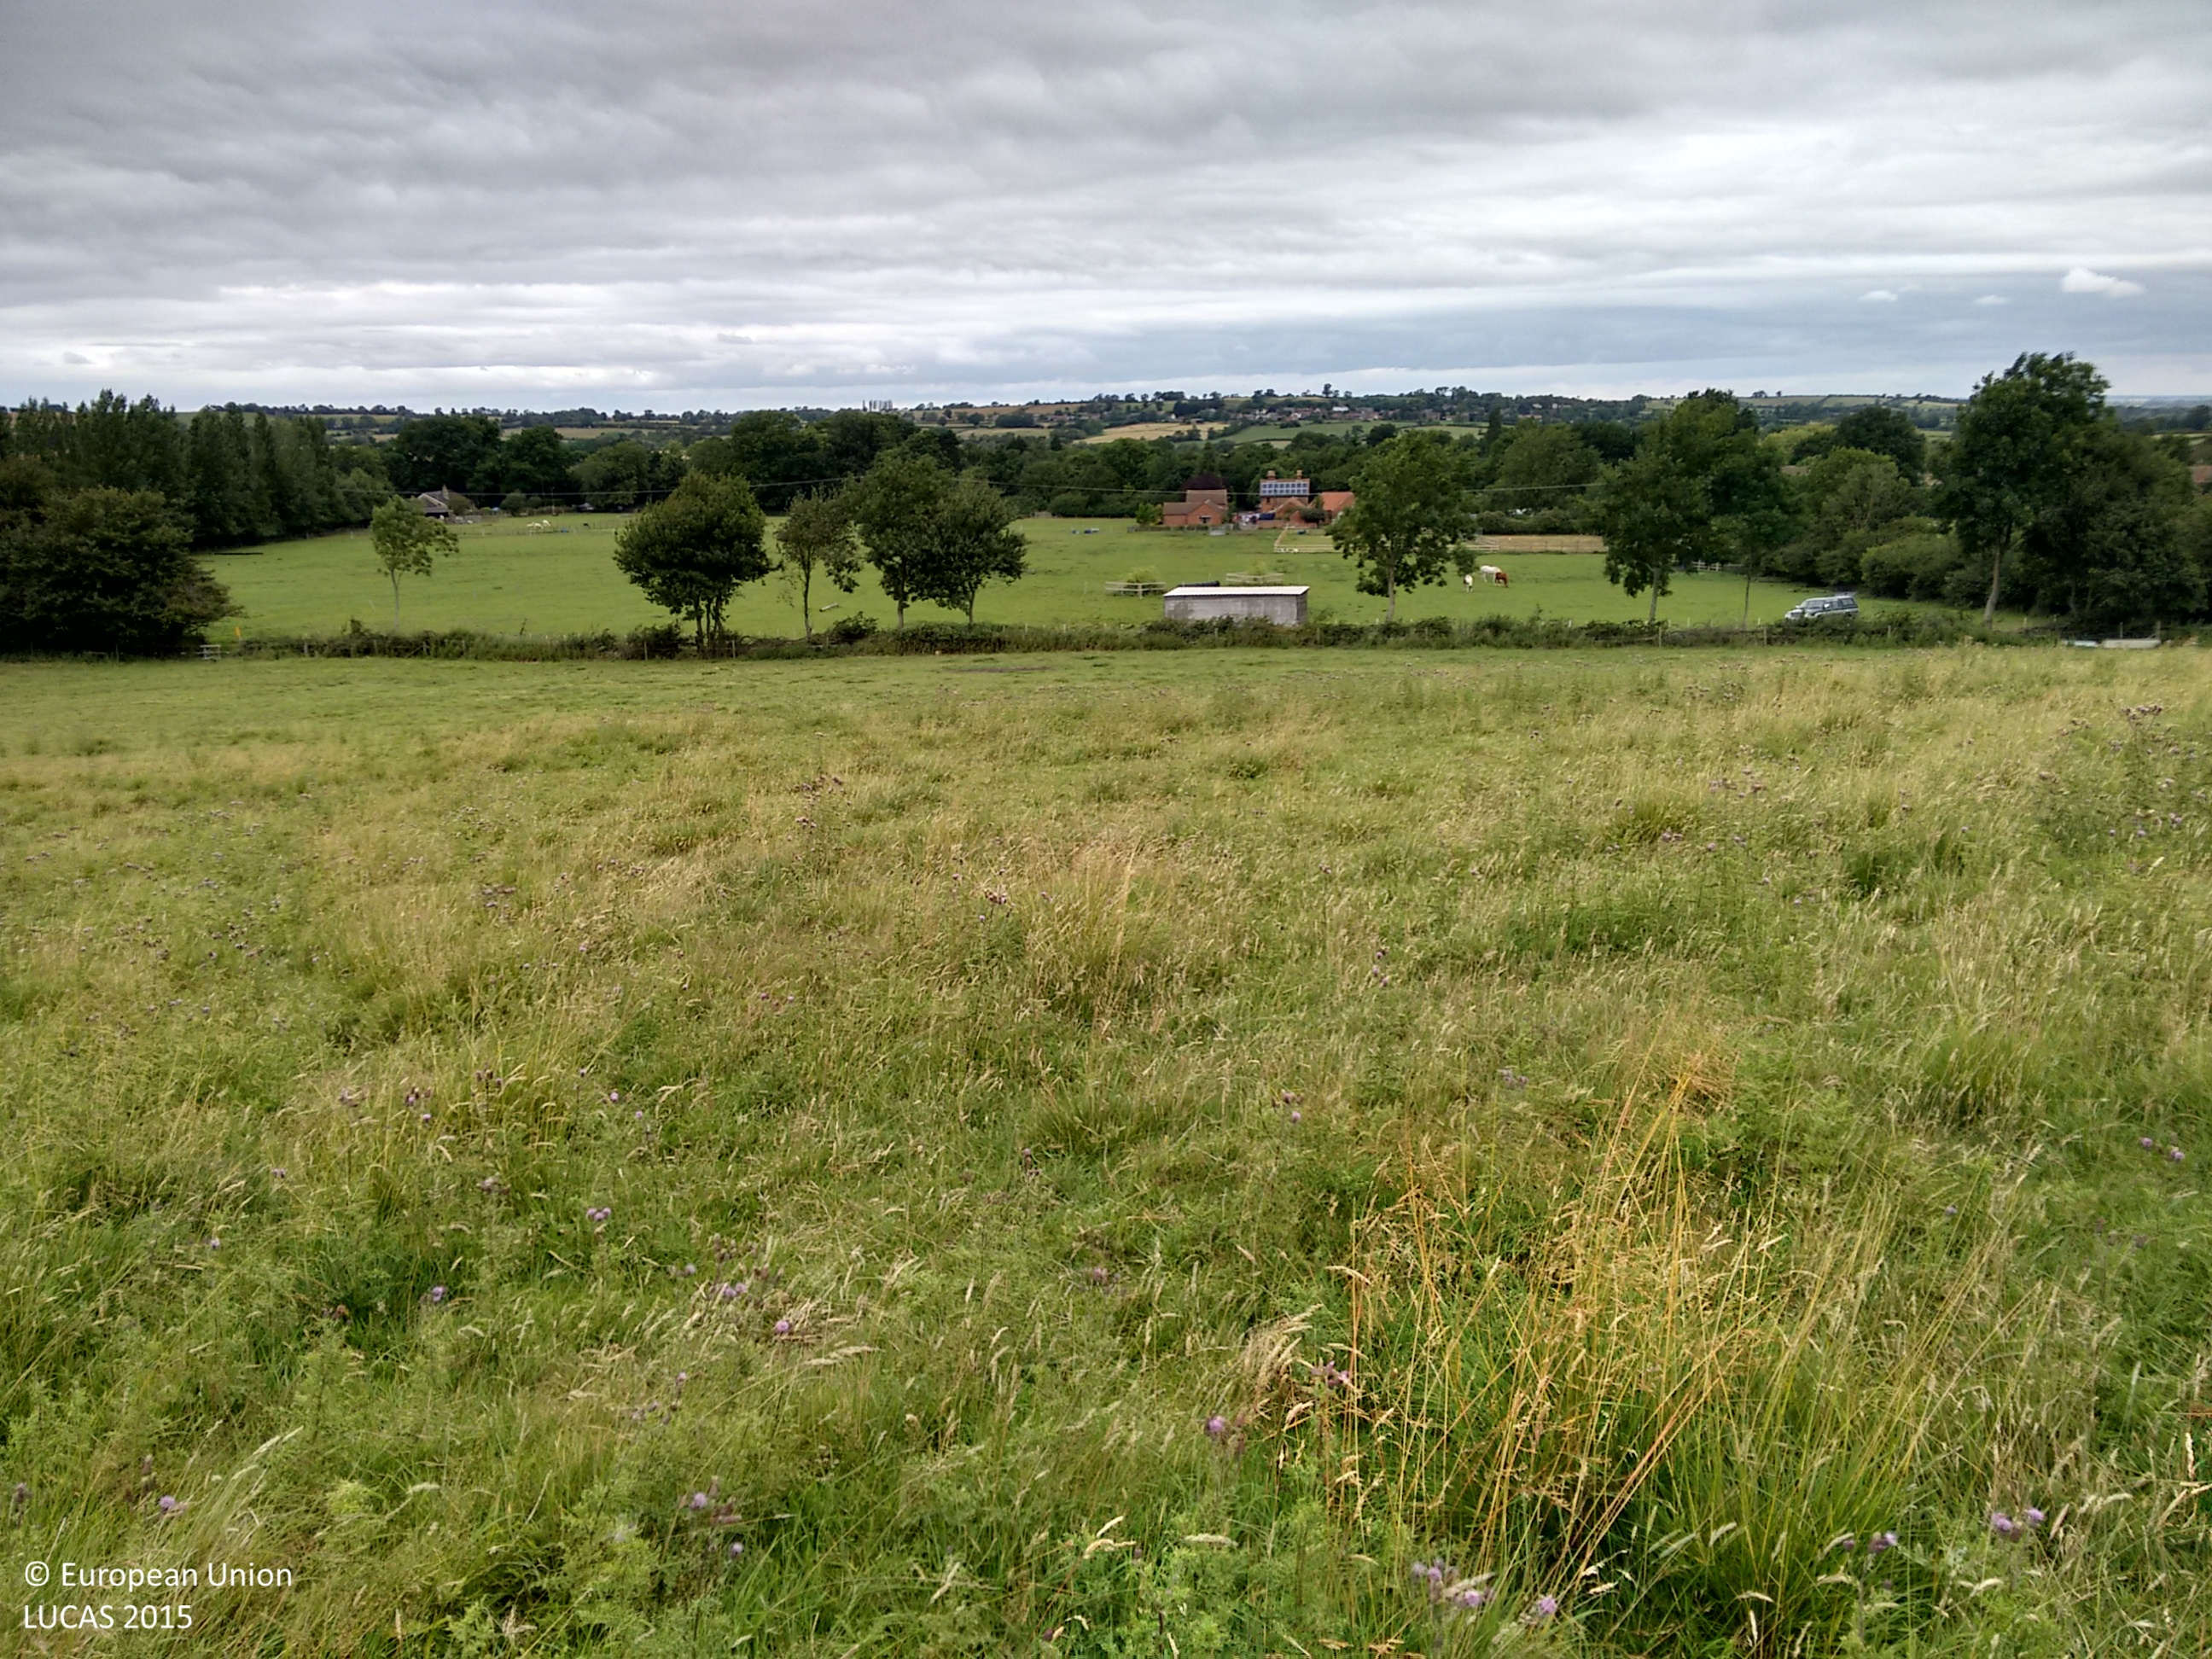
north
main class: Grassland
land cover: Grassland without tree/shrub cover
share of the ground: > 75 %
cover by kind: herbaceous plants 100 %
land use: Agriculture (excluding fallow land and kitchen gardens)
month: July
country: GB
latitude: 52.8105
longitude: -0.9776
